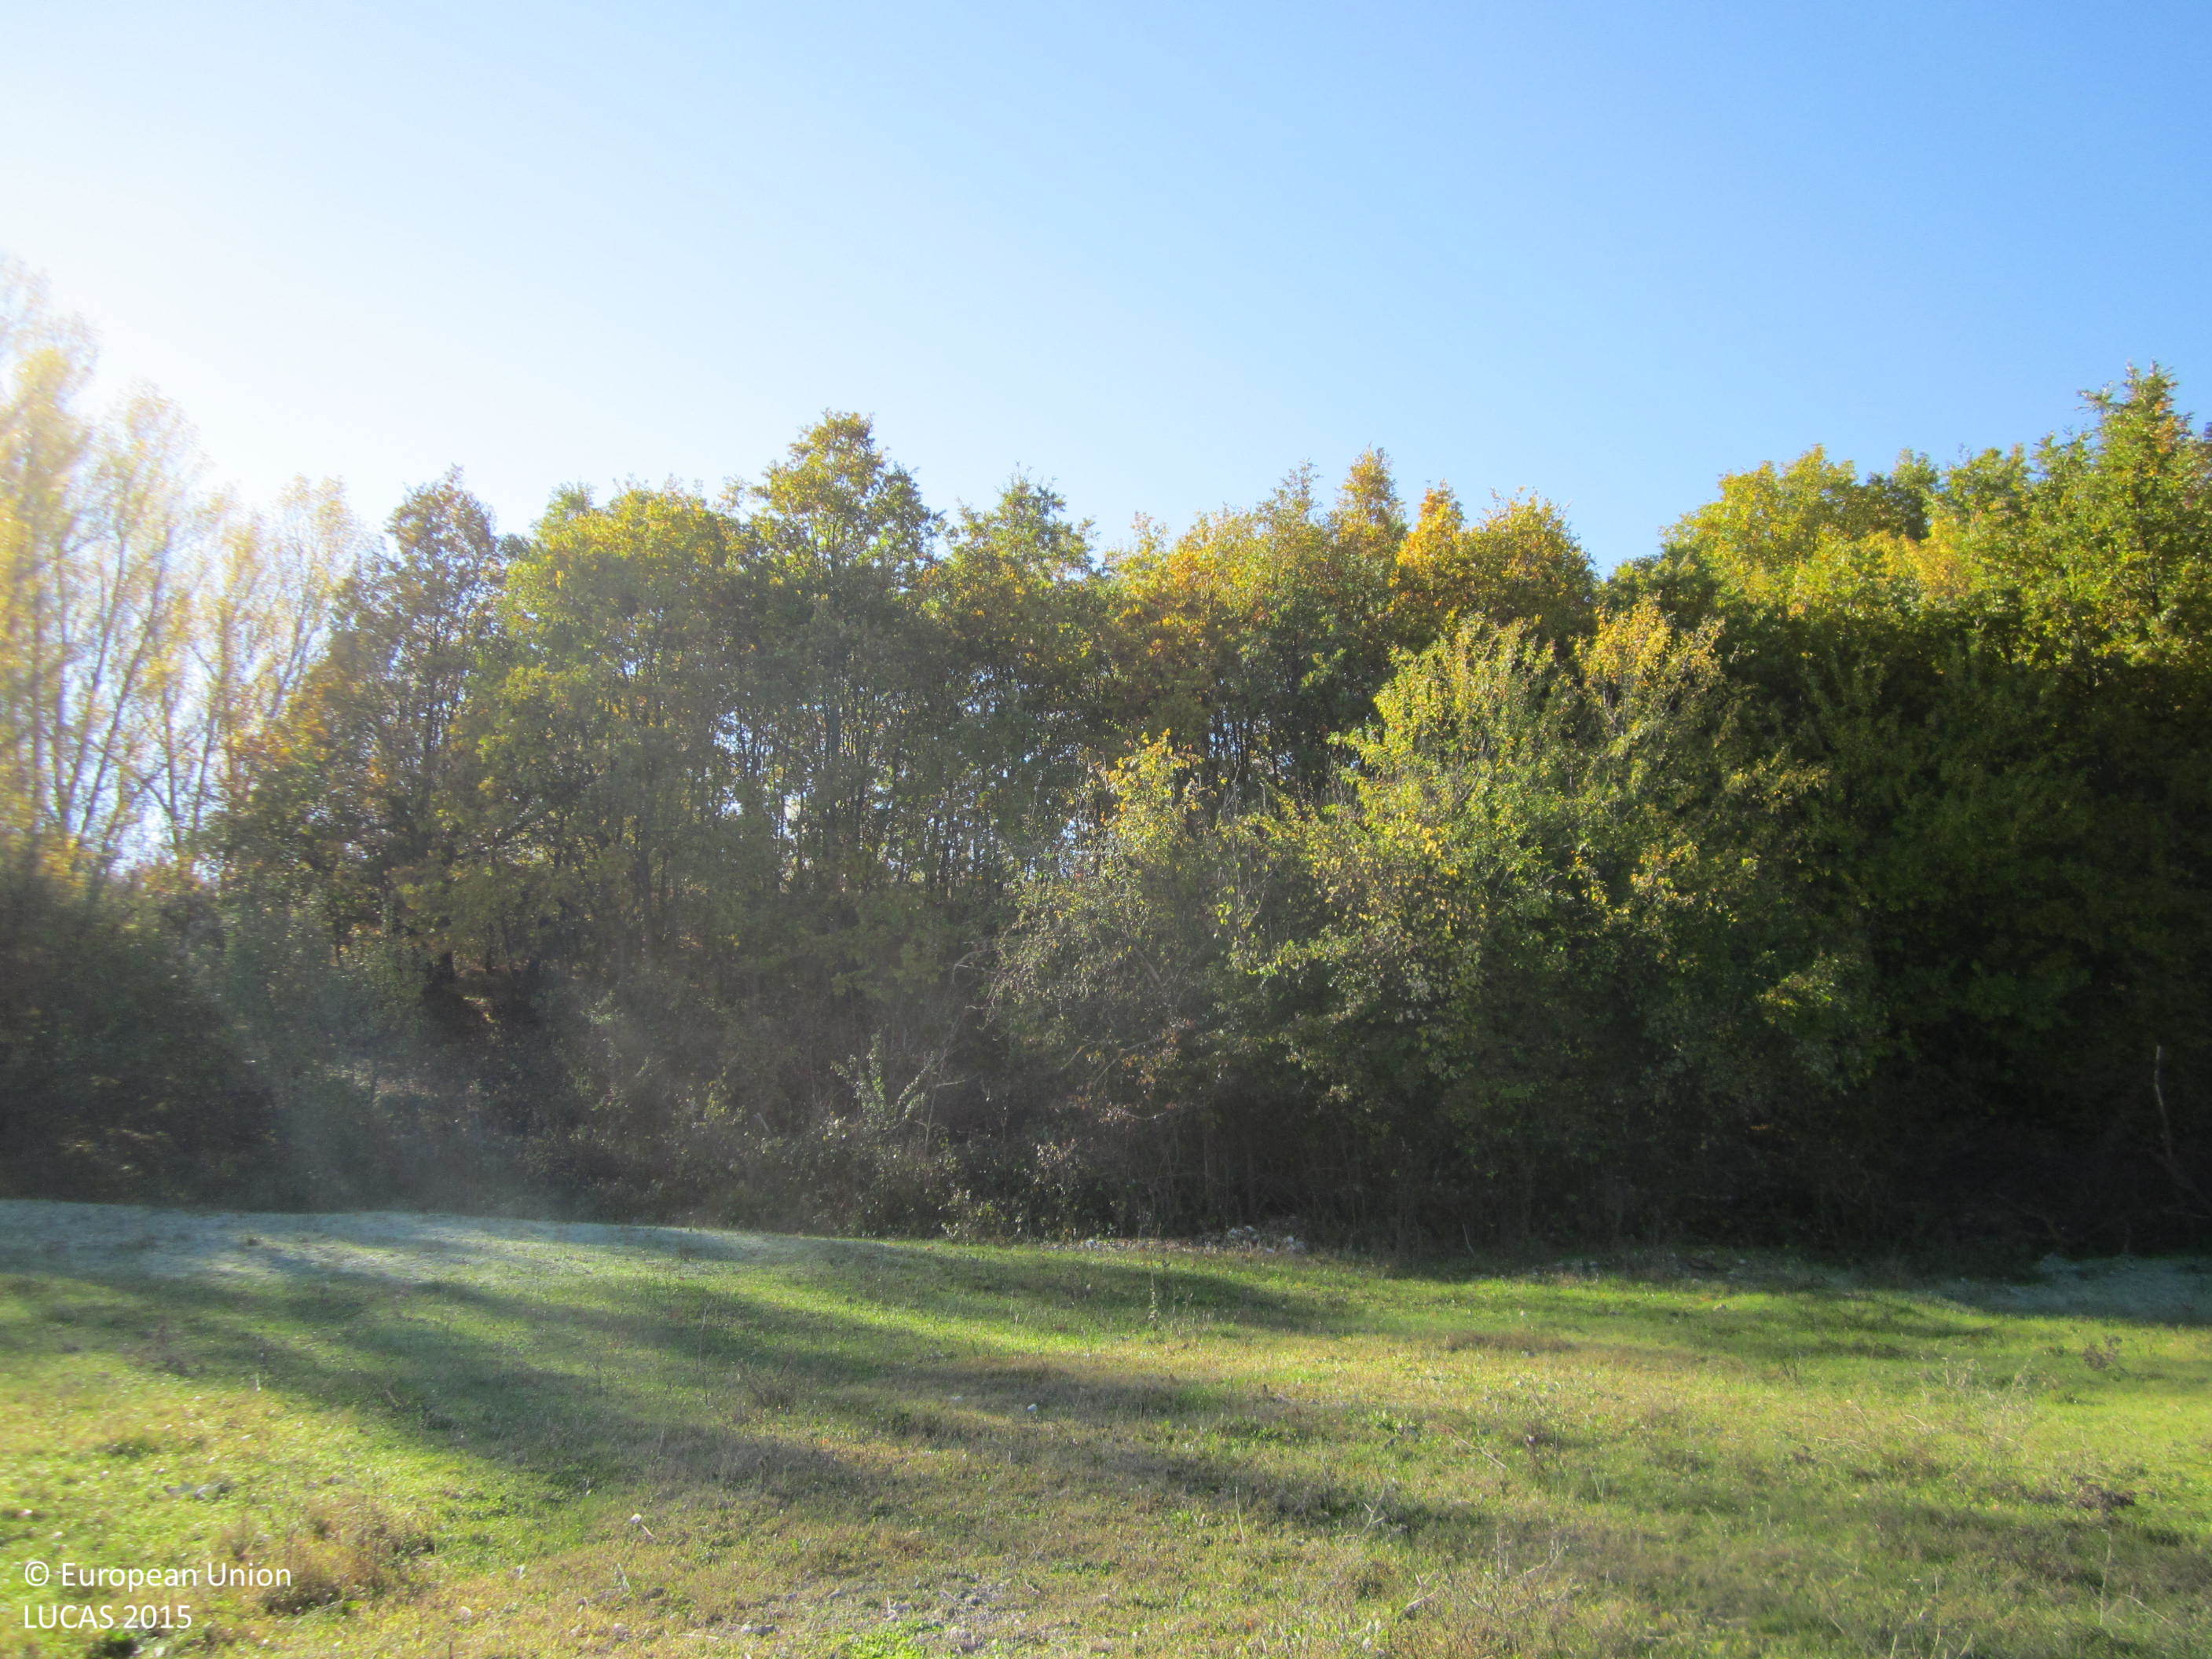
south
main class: Grassland
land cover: Grassland without tree/shrub cover
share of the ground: > 75 %
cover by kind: herbaceous plants 100 %
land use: Agriculture (excluding fallow land and kitchen gardens)
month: November
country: BG
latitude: 41.4424
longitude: 25.6797
